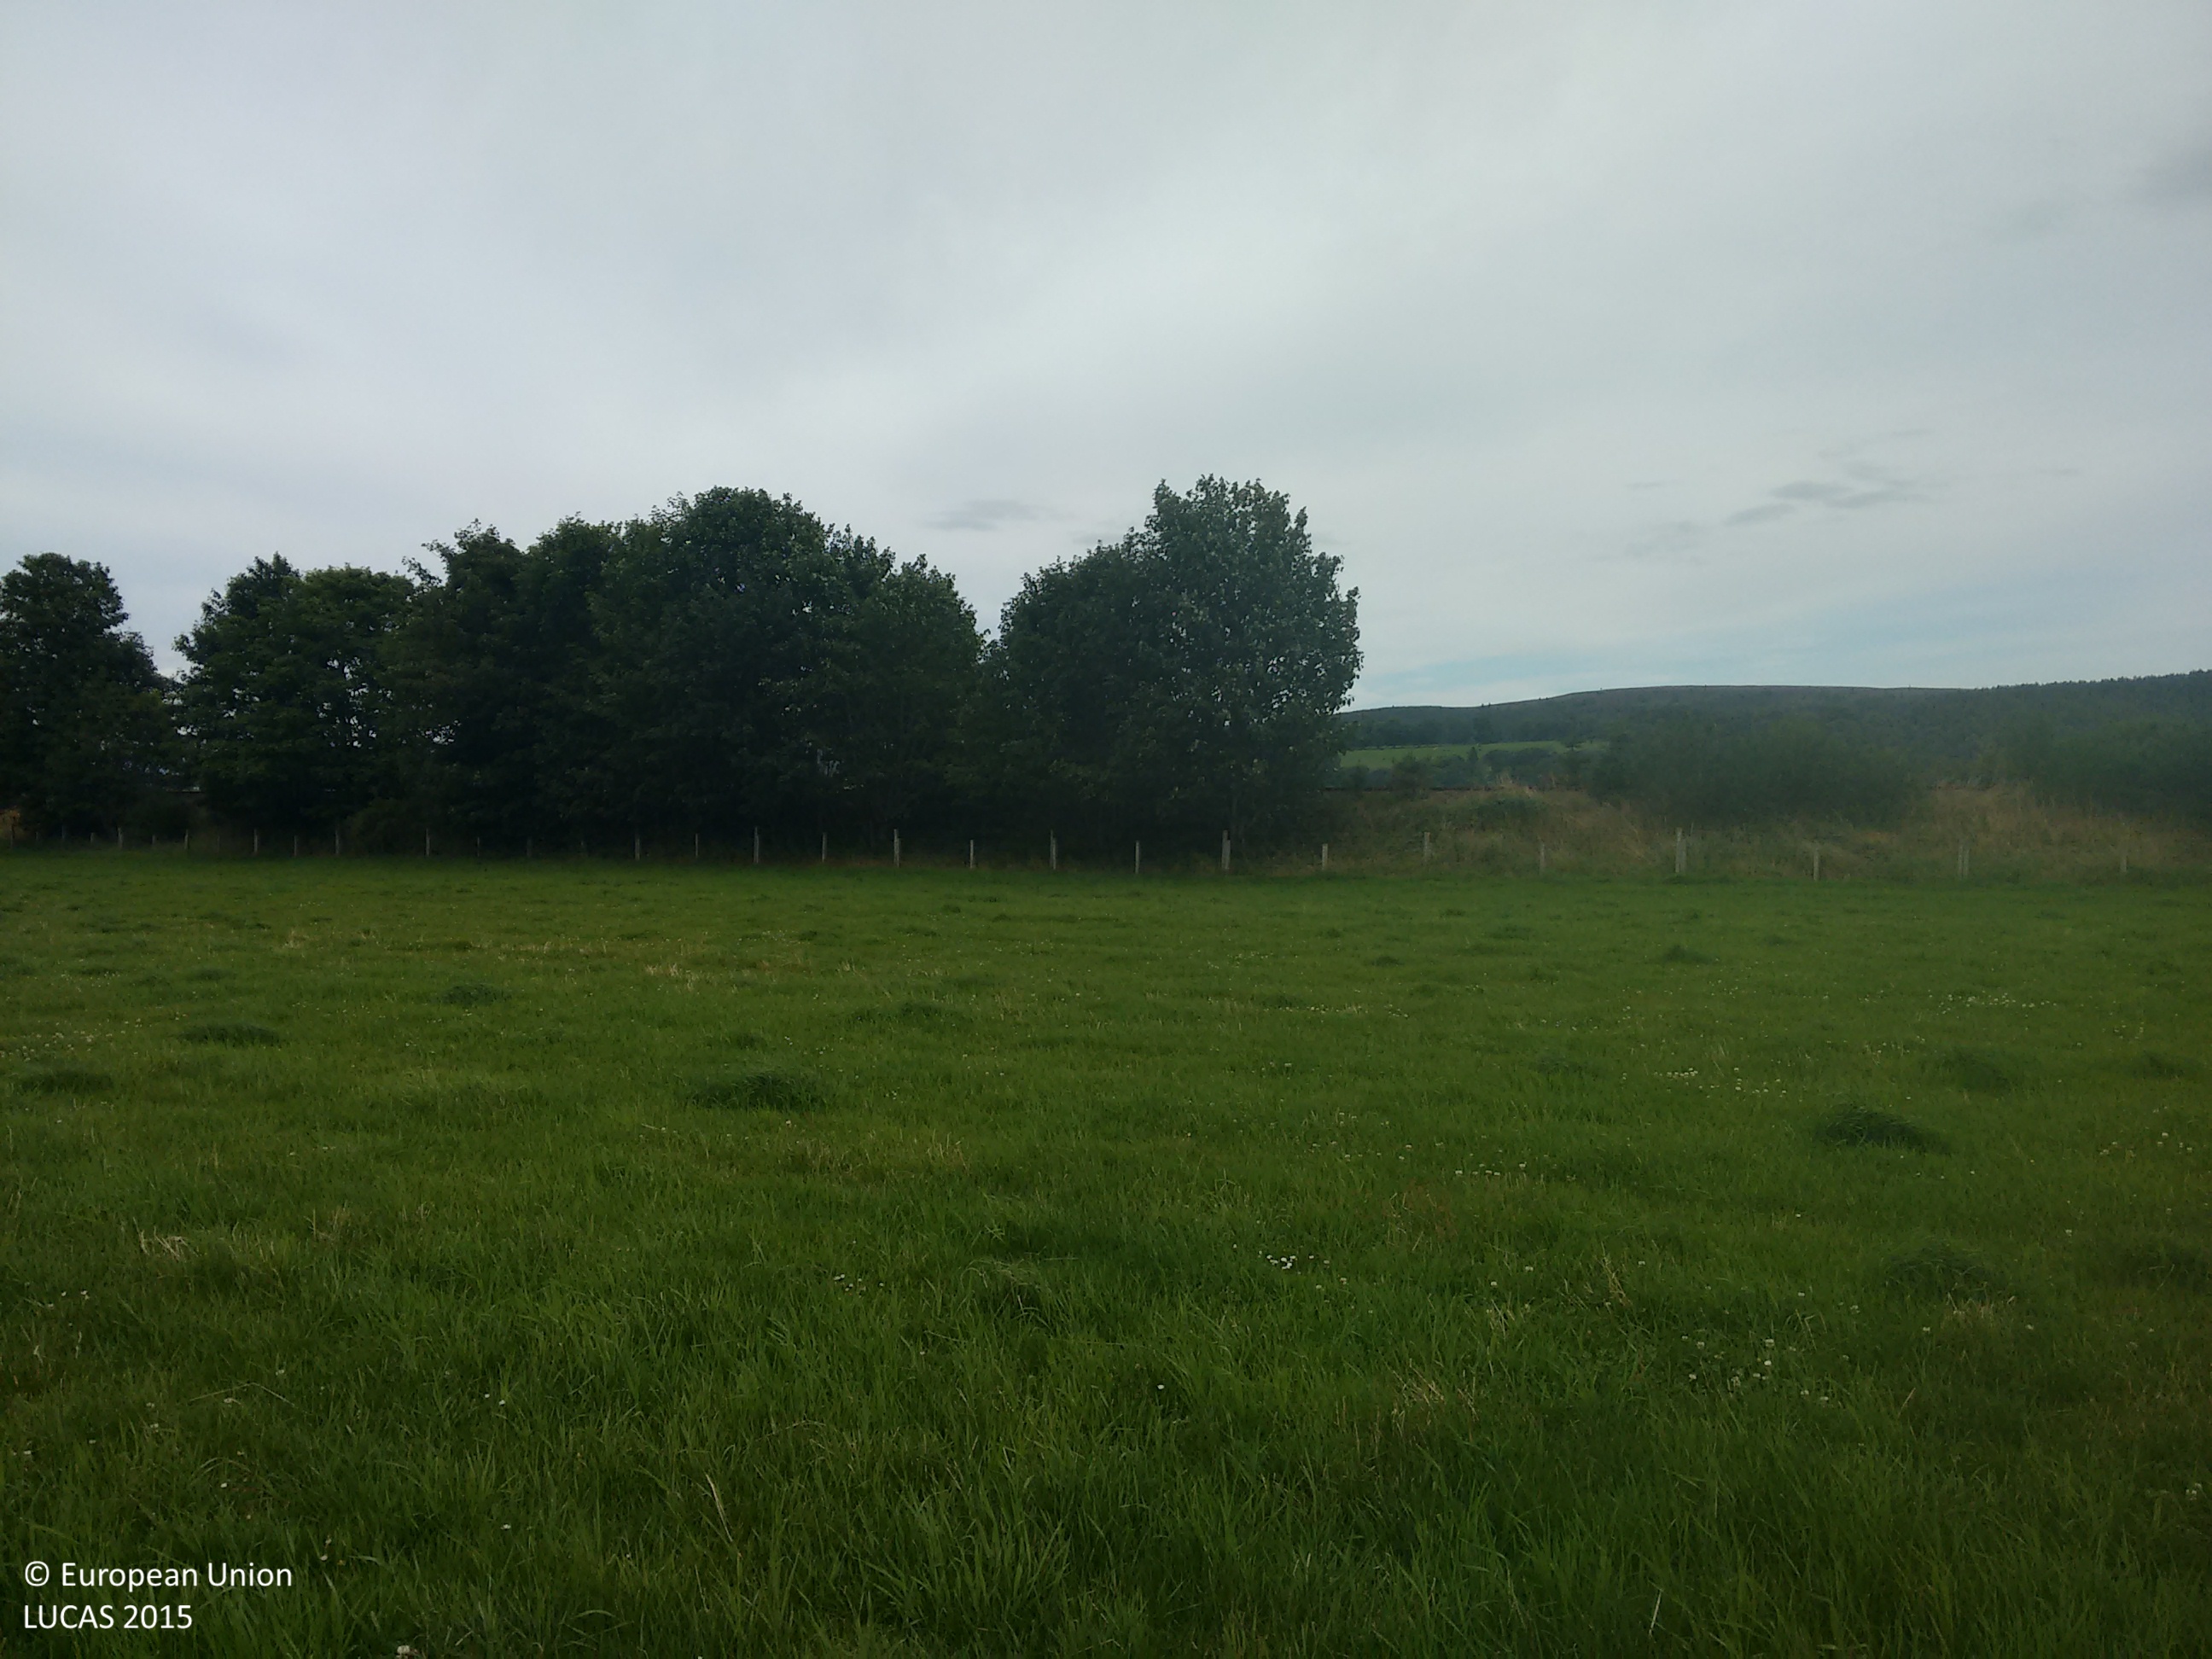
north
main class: Grassland
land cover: Grassland without tree/shrub cover
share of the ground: > 75 %
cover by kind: herbaceous plants 100 %
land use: Agriculture (excluding fallow land and kitchen gardens)
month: September
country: GB
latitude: 57.8532
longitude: -4.2893
